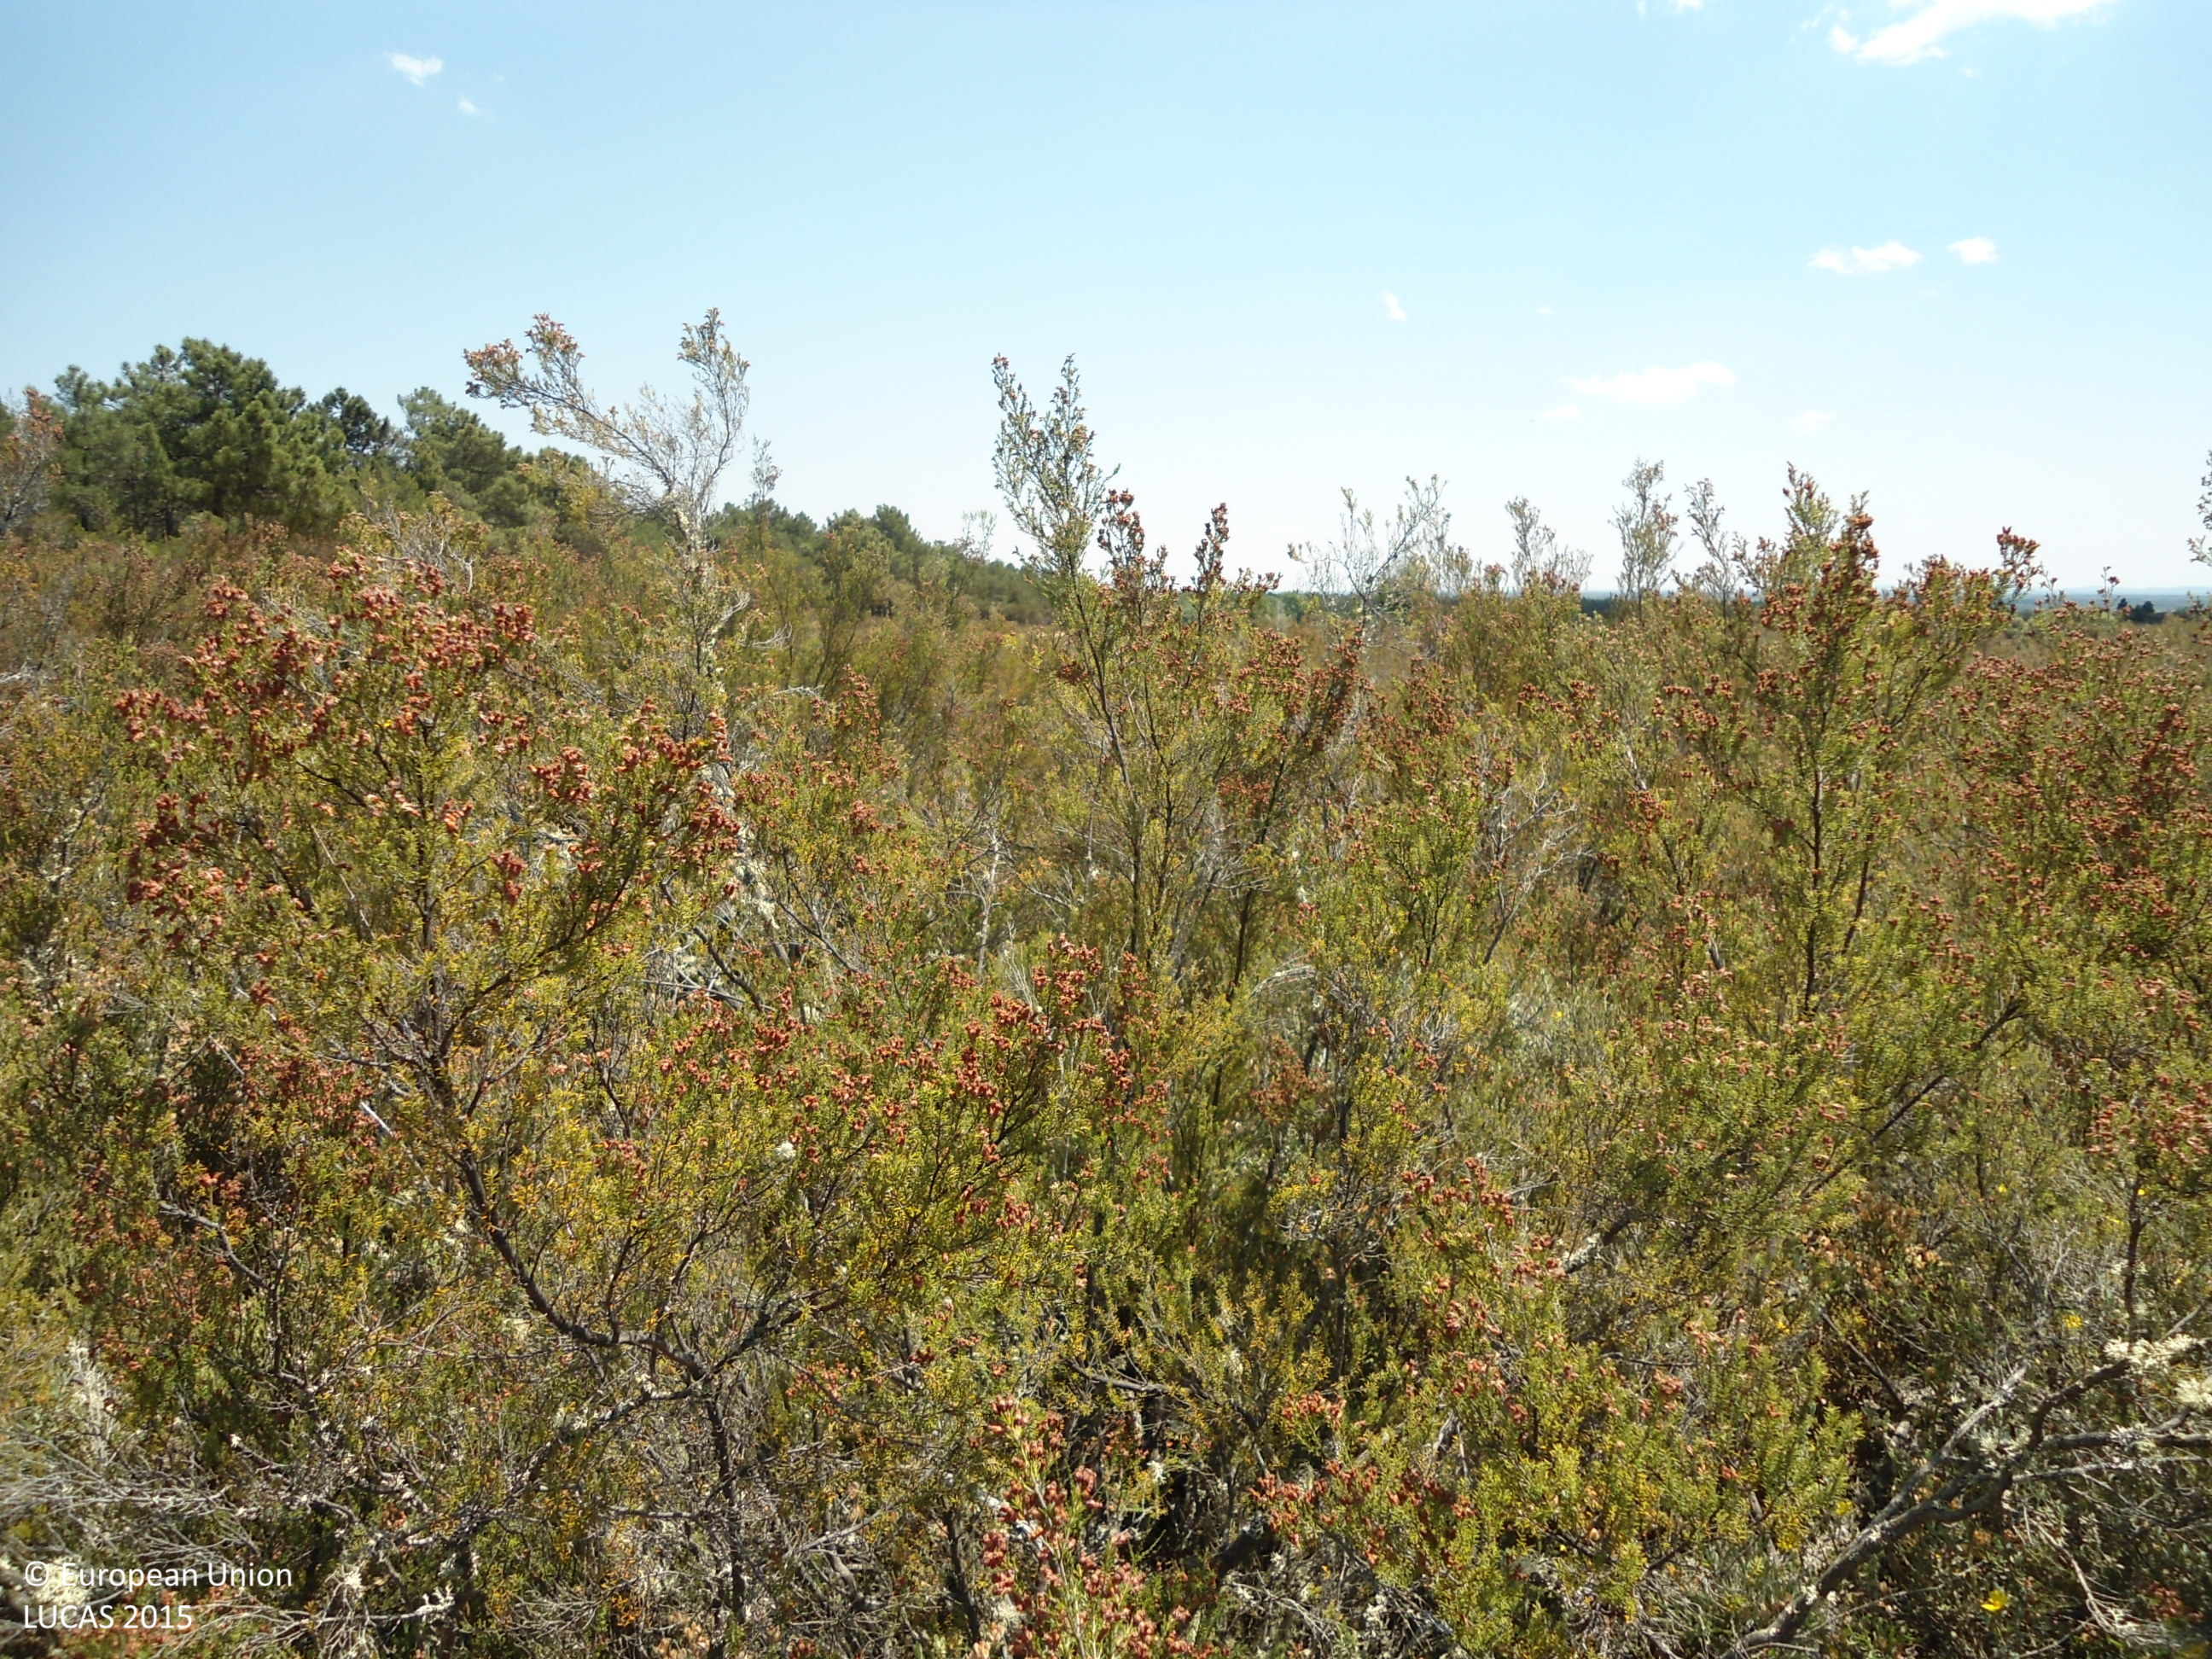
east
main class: Shrubland
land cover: Shrubland with sparse tree cover
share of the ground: > 75 %
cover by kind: shrubs 95 %, broadleaved forest trees 5 %
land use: Semi-natural and natural areas not in use
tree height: < 5 m
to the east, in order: Shrubland with sparse tree cover; Shrubland without tree cover; Other bare soil; Tracks; Other bare soil; Pine dominated coniferous woodland
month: June
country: ES
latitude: 42.1038
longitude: -6.2490
